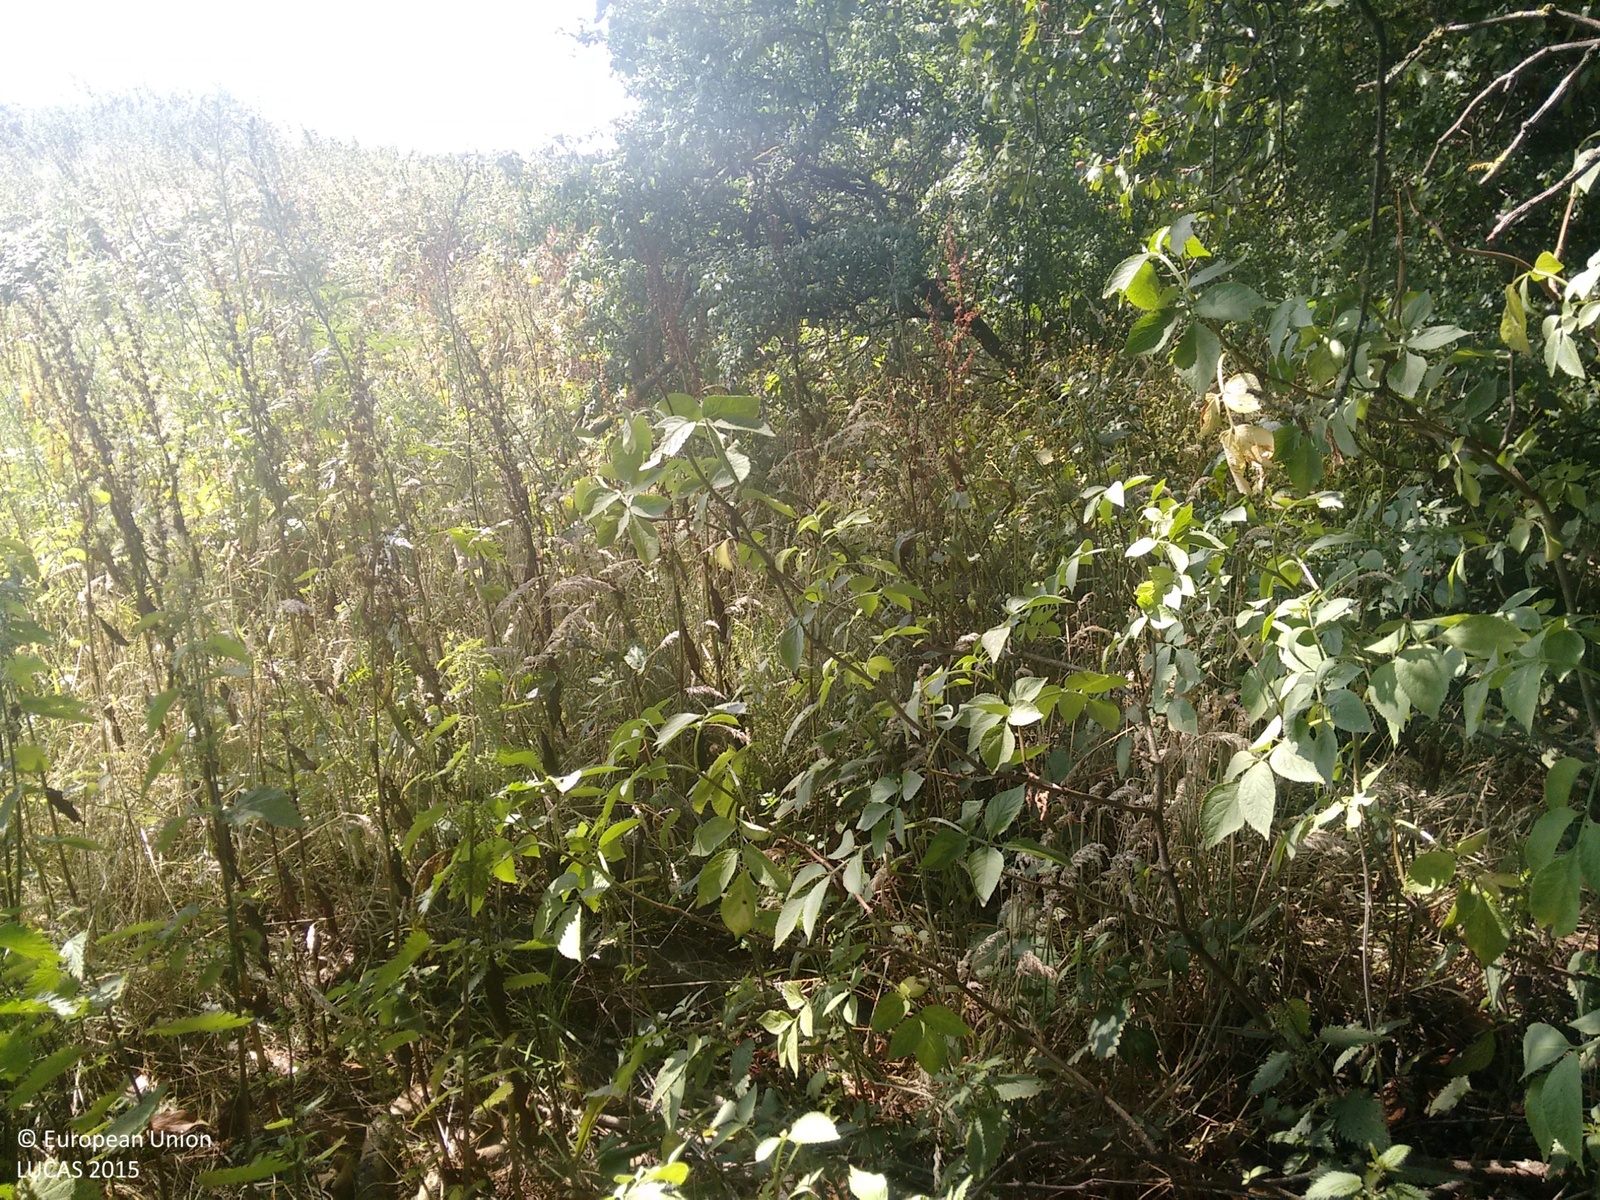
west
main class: Grassland
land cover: Grassland without tree/shrub cover
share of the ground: > 75 %
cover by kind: herbaceous plants 100 %
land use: Semi-natural and natural areas not in use
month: July
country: GB
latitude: 52.4457
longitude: -1.7511
